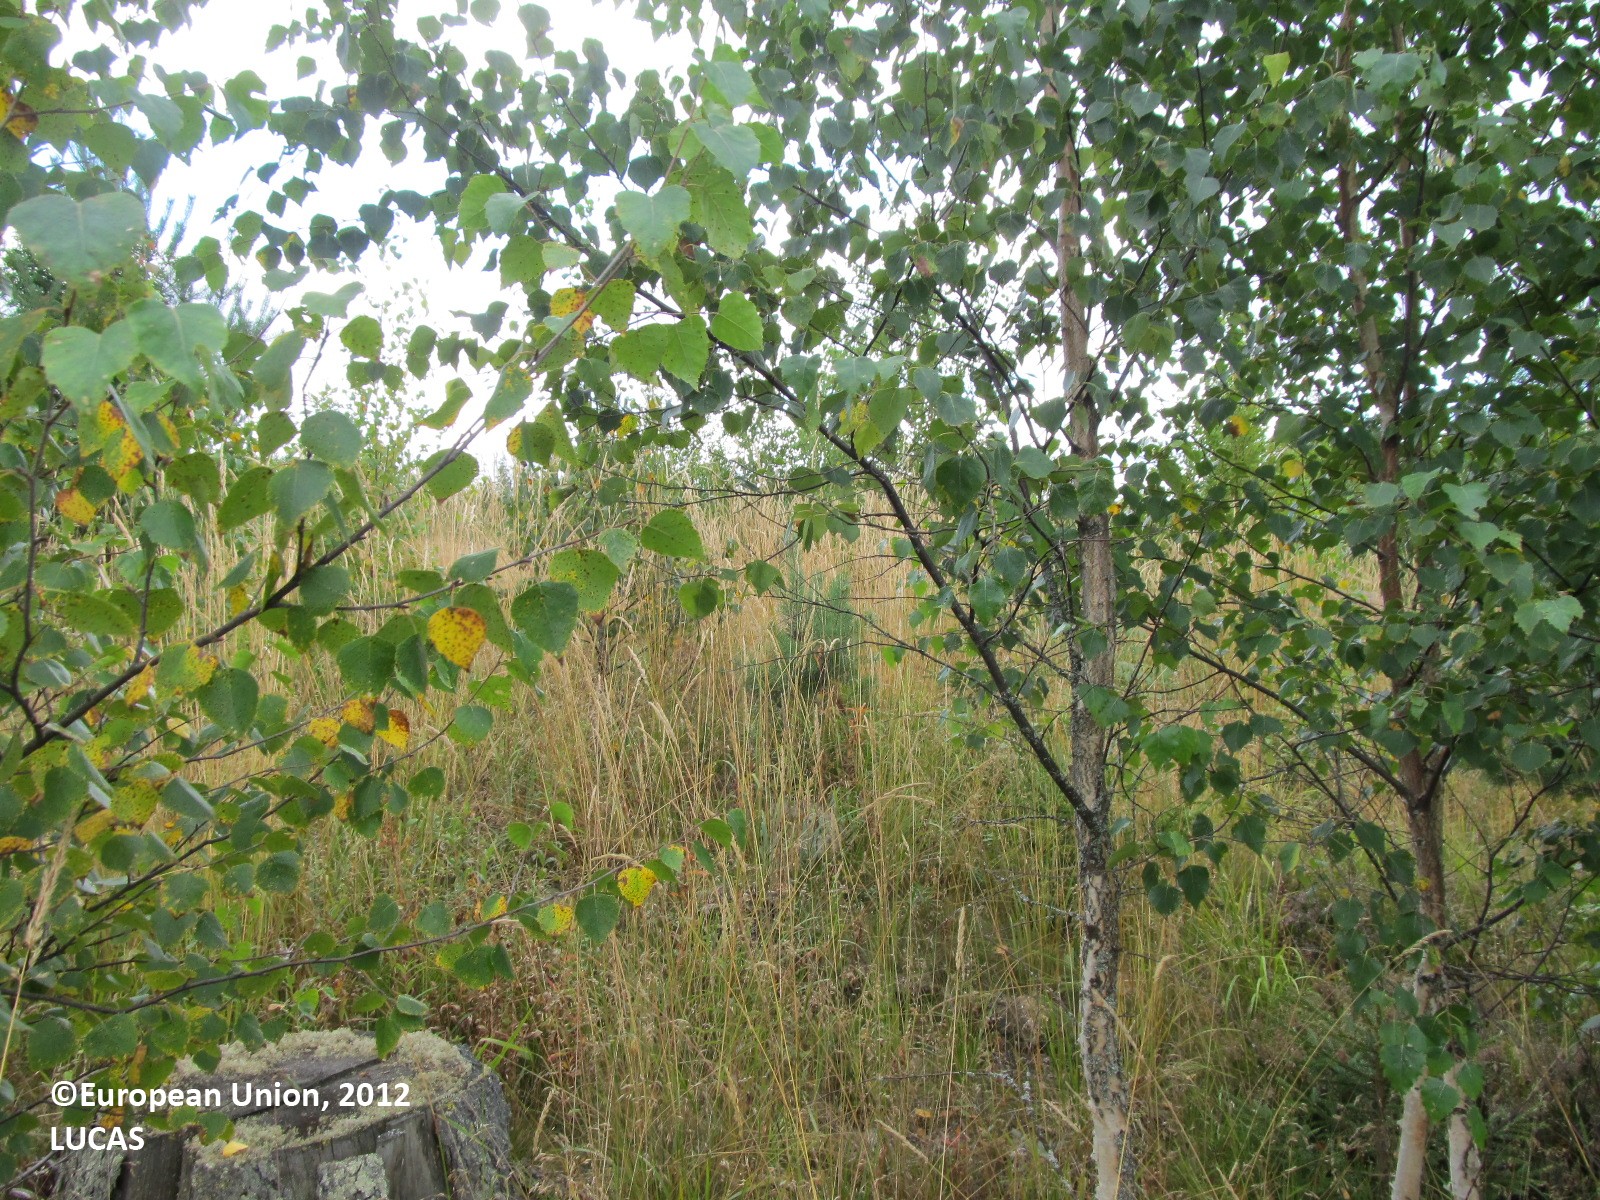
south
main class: Woodland
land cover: Spruce dominated mixed woodland
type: boreal forest
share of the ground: 25 - 50 %
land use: Forestry
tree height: < 5 m
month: August
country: FI
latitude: 61.7100
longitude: 27.7553
